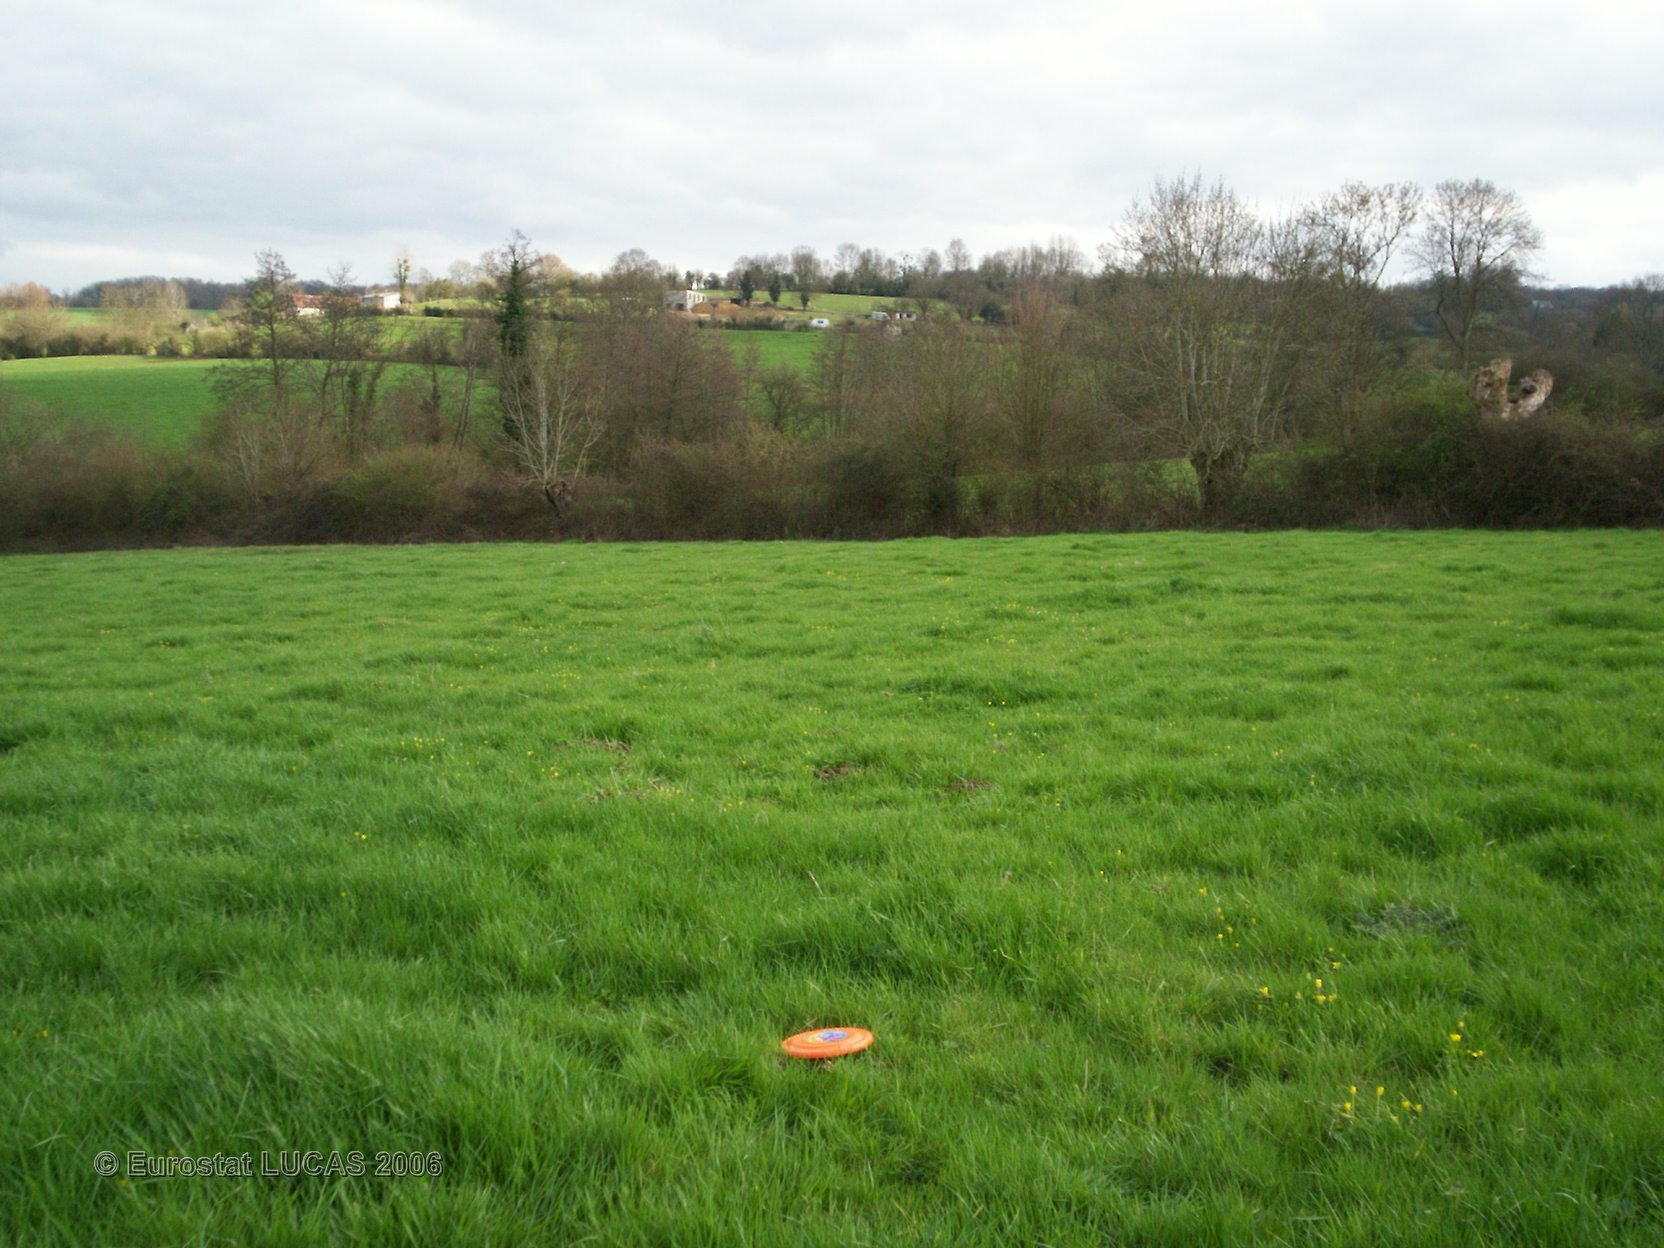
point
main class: Grassland
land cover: Grassland without tree/shrub cover
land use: Agriculture (excluding fallow land and kitchen gardens)
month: April
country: FR
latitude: 48.8989
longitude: 0.0804
